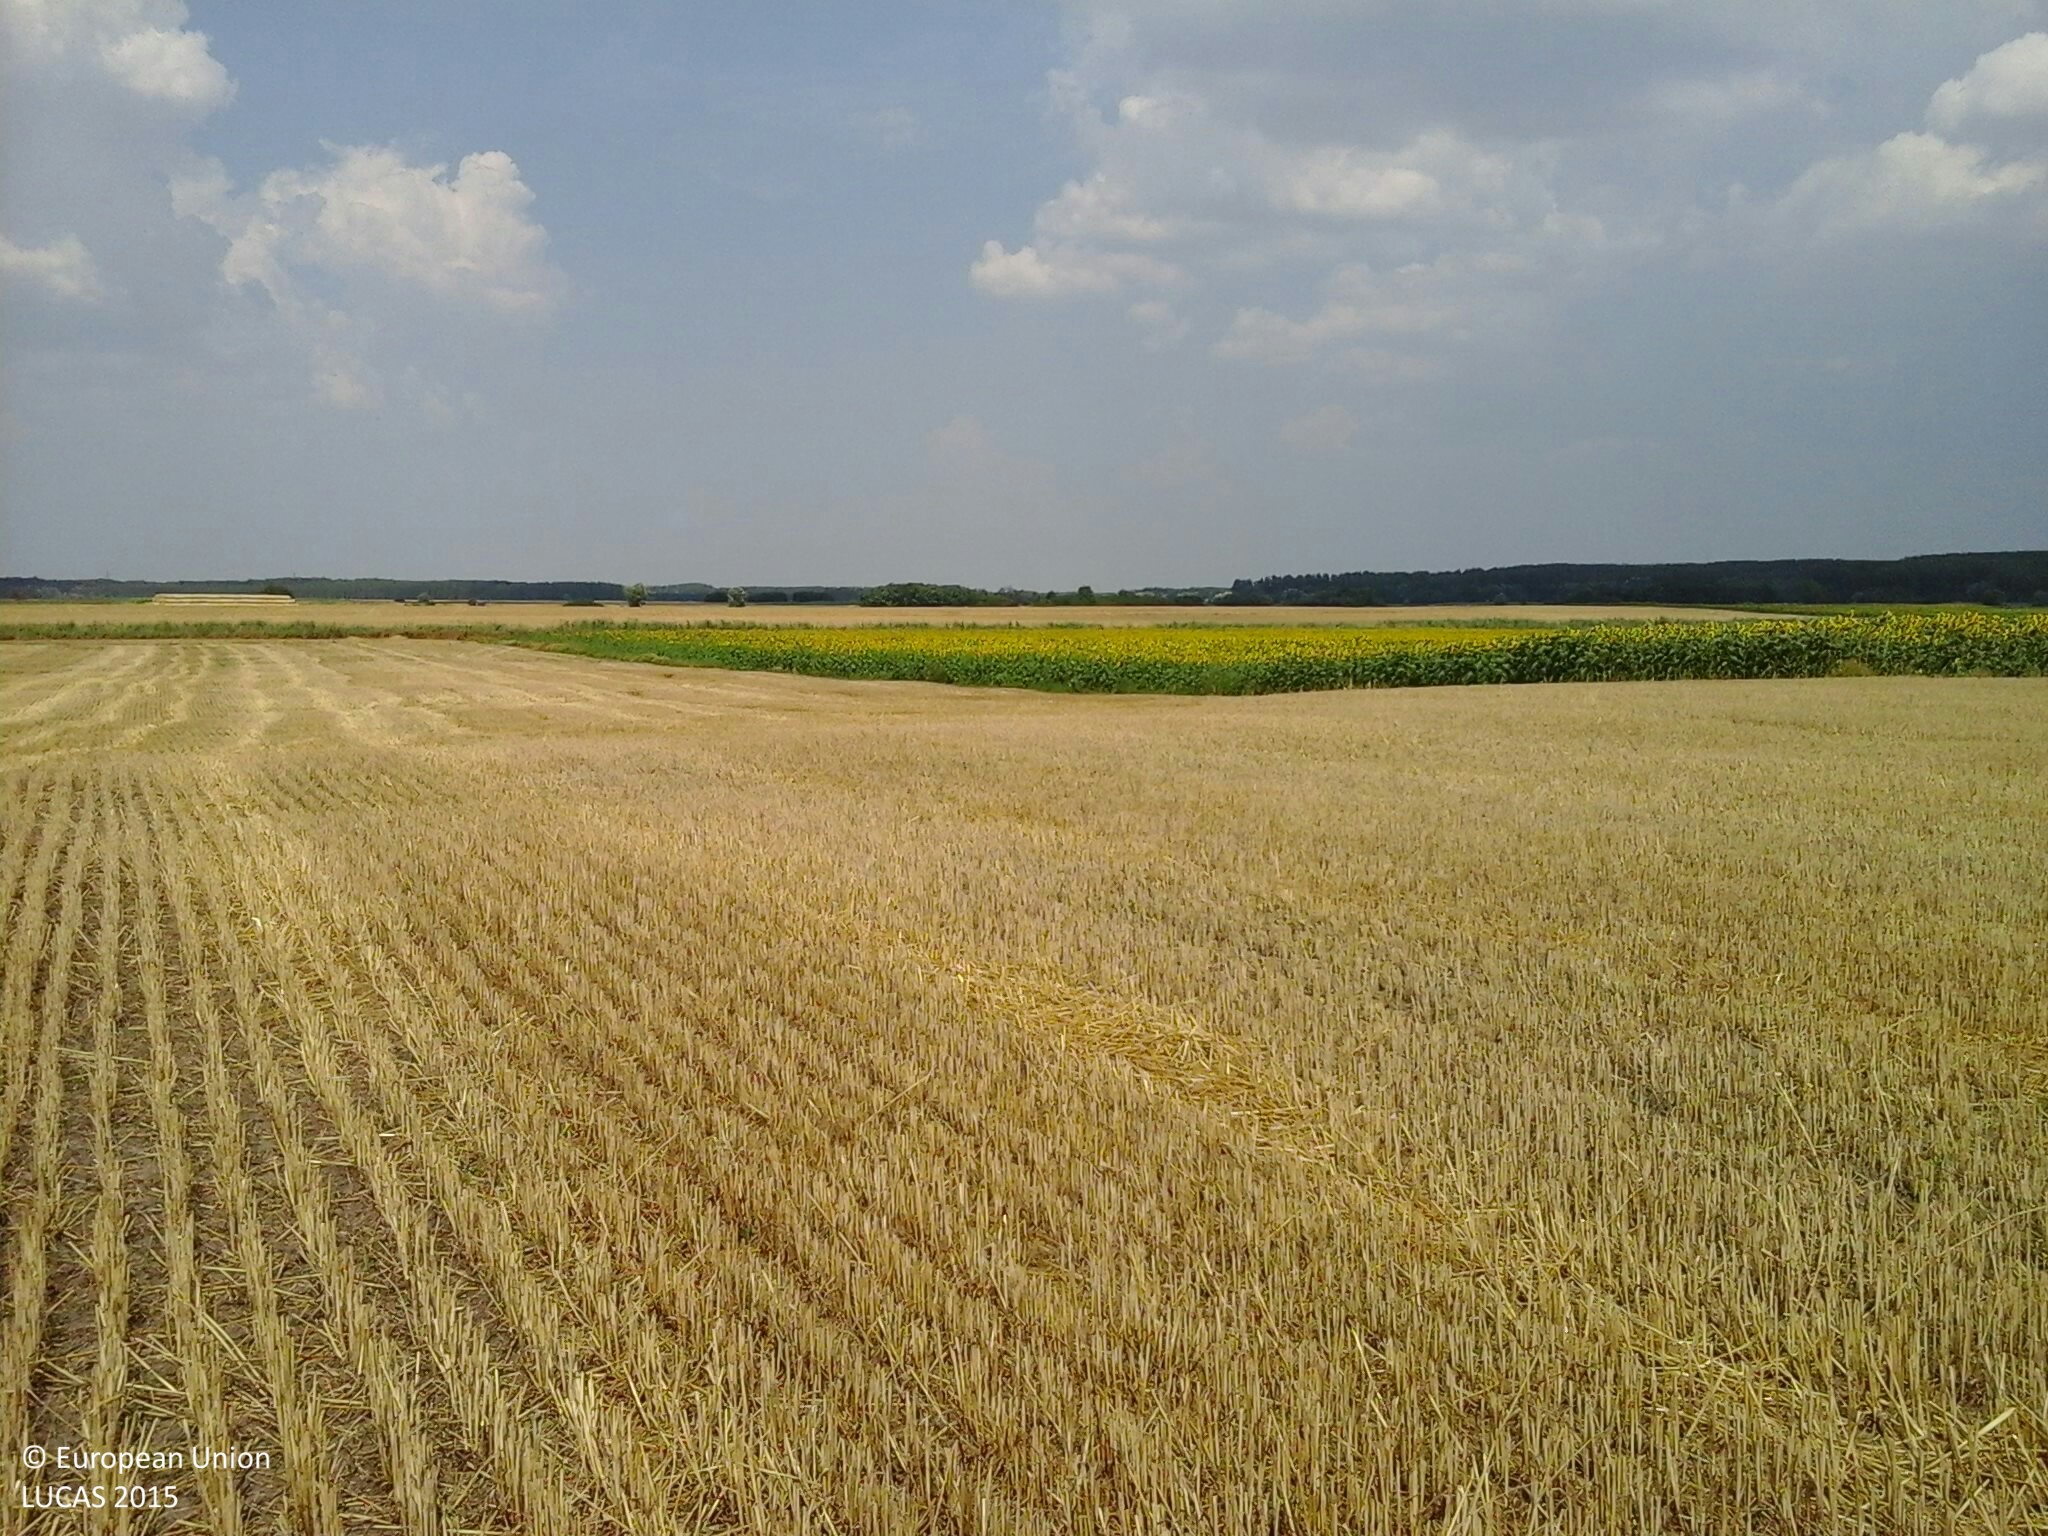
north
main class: Cropland
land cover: Common wheat
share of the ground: 25 - 50 %
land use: Agriculture (excluding fallow land and kitchen gardens)
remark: Harvested field
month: July
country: HU
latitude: 47.7016
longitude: 21.0590
